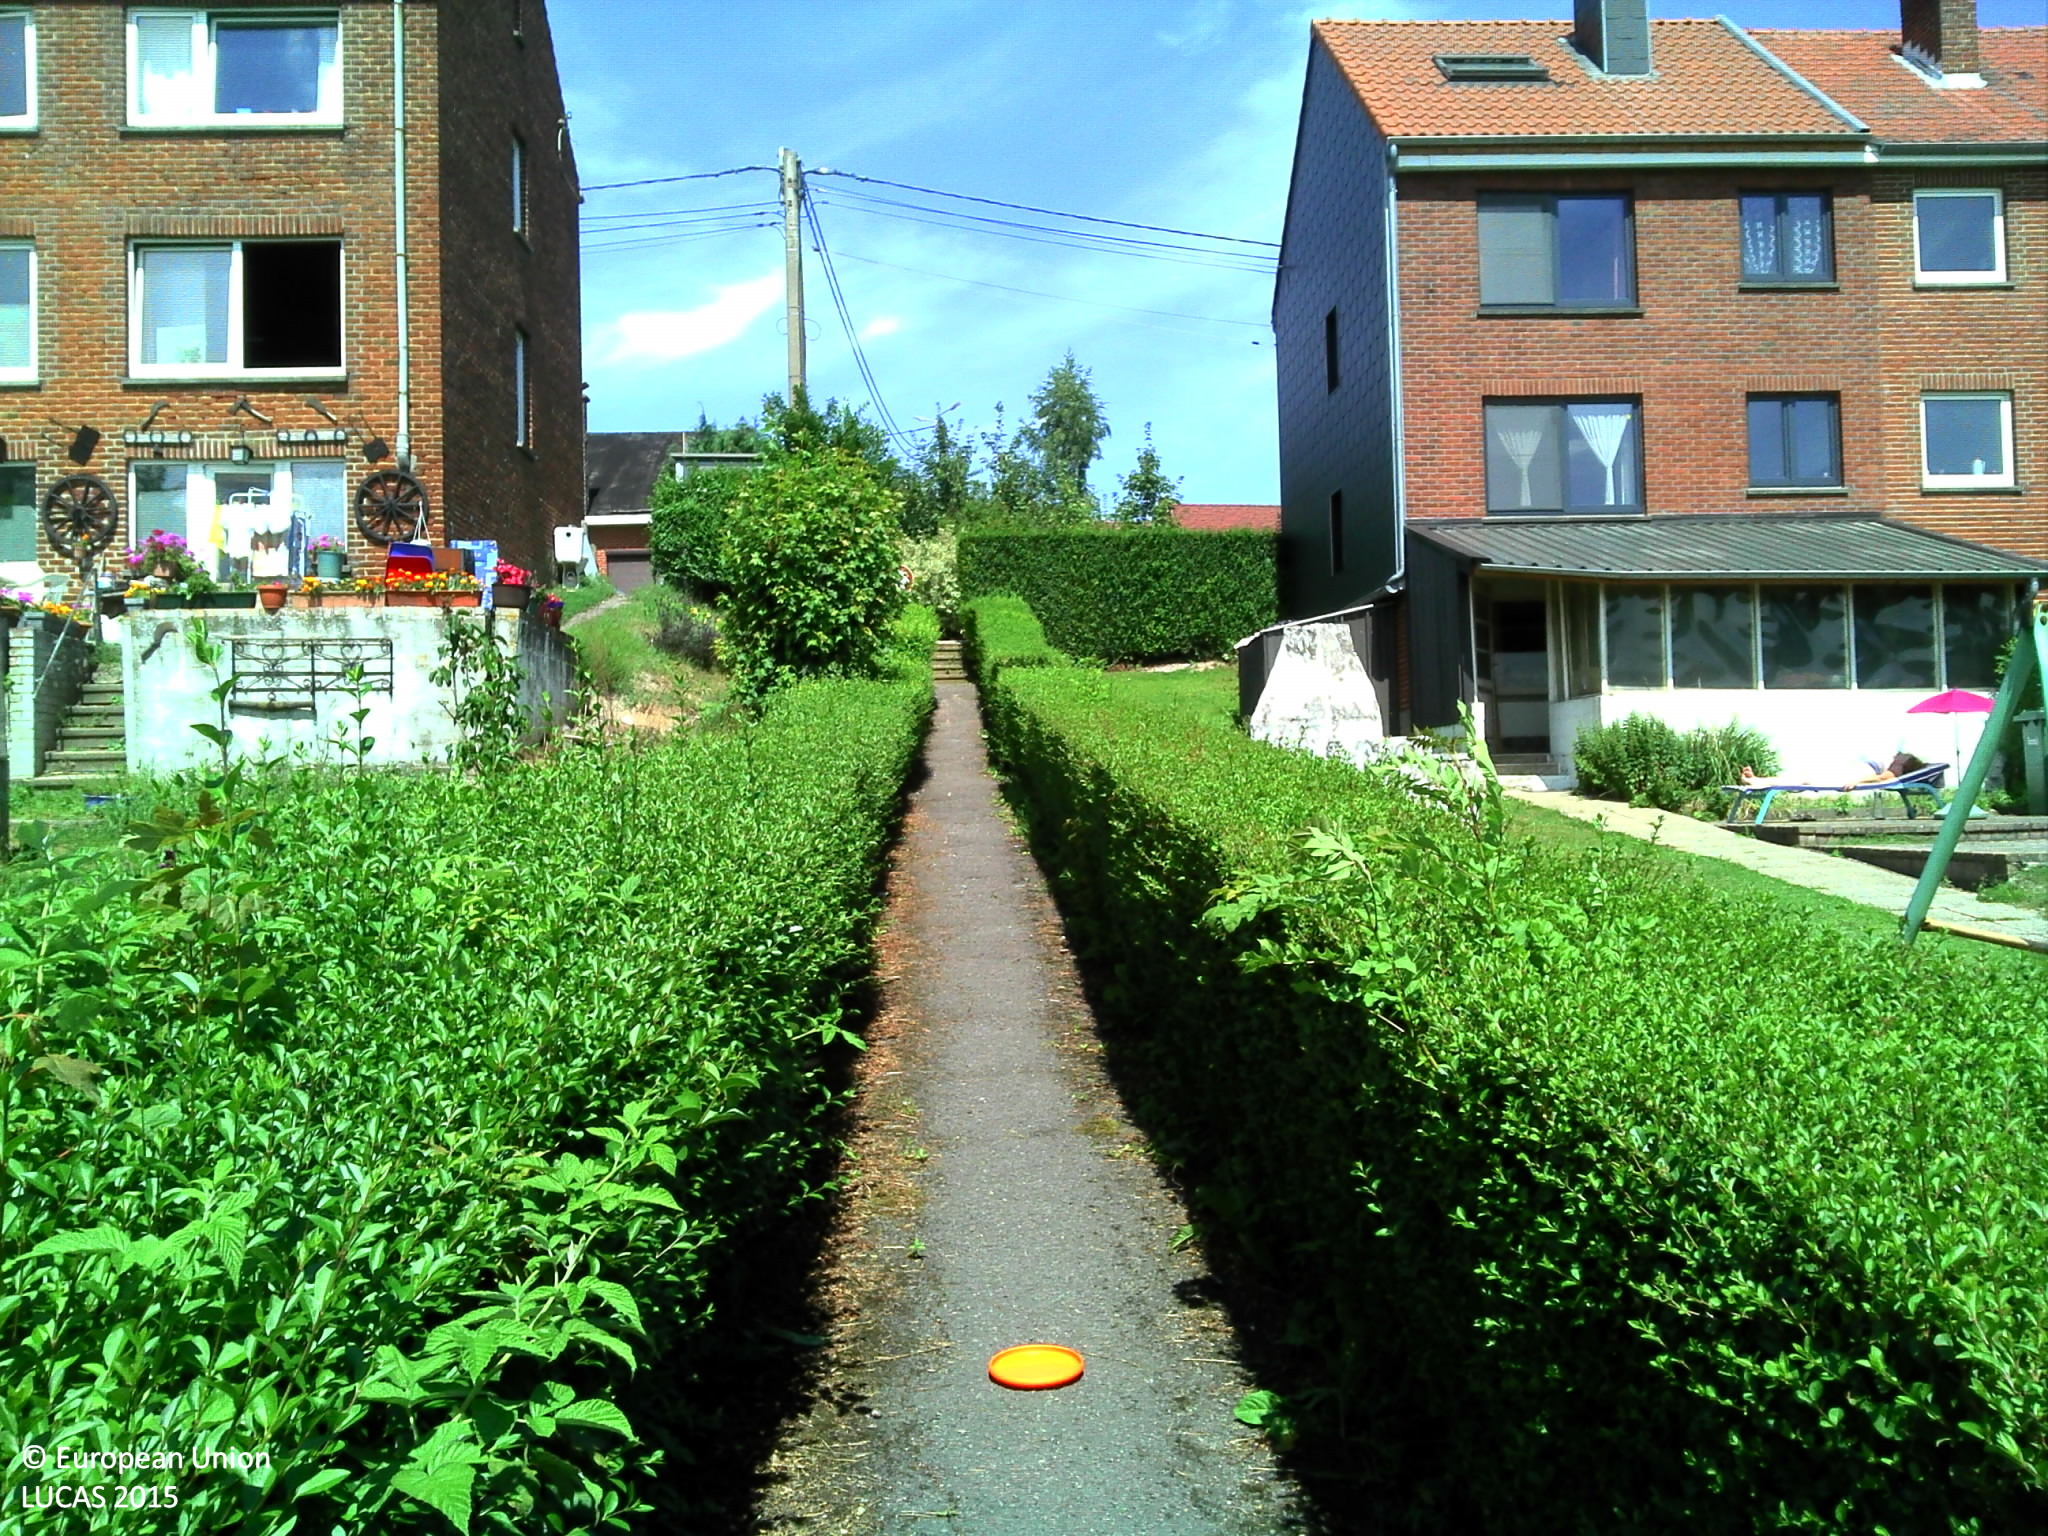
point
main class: Grassland
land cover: Grassland without tree/shrub cover
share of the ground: > 75 %
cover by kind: herbaceous plants 100 %
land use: Residential
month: August
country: BE
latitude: 50.3593
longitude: 4.5280
